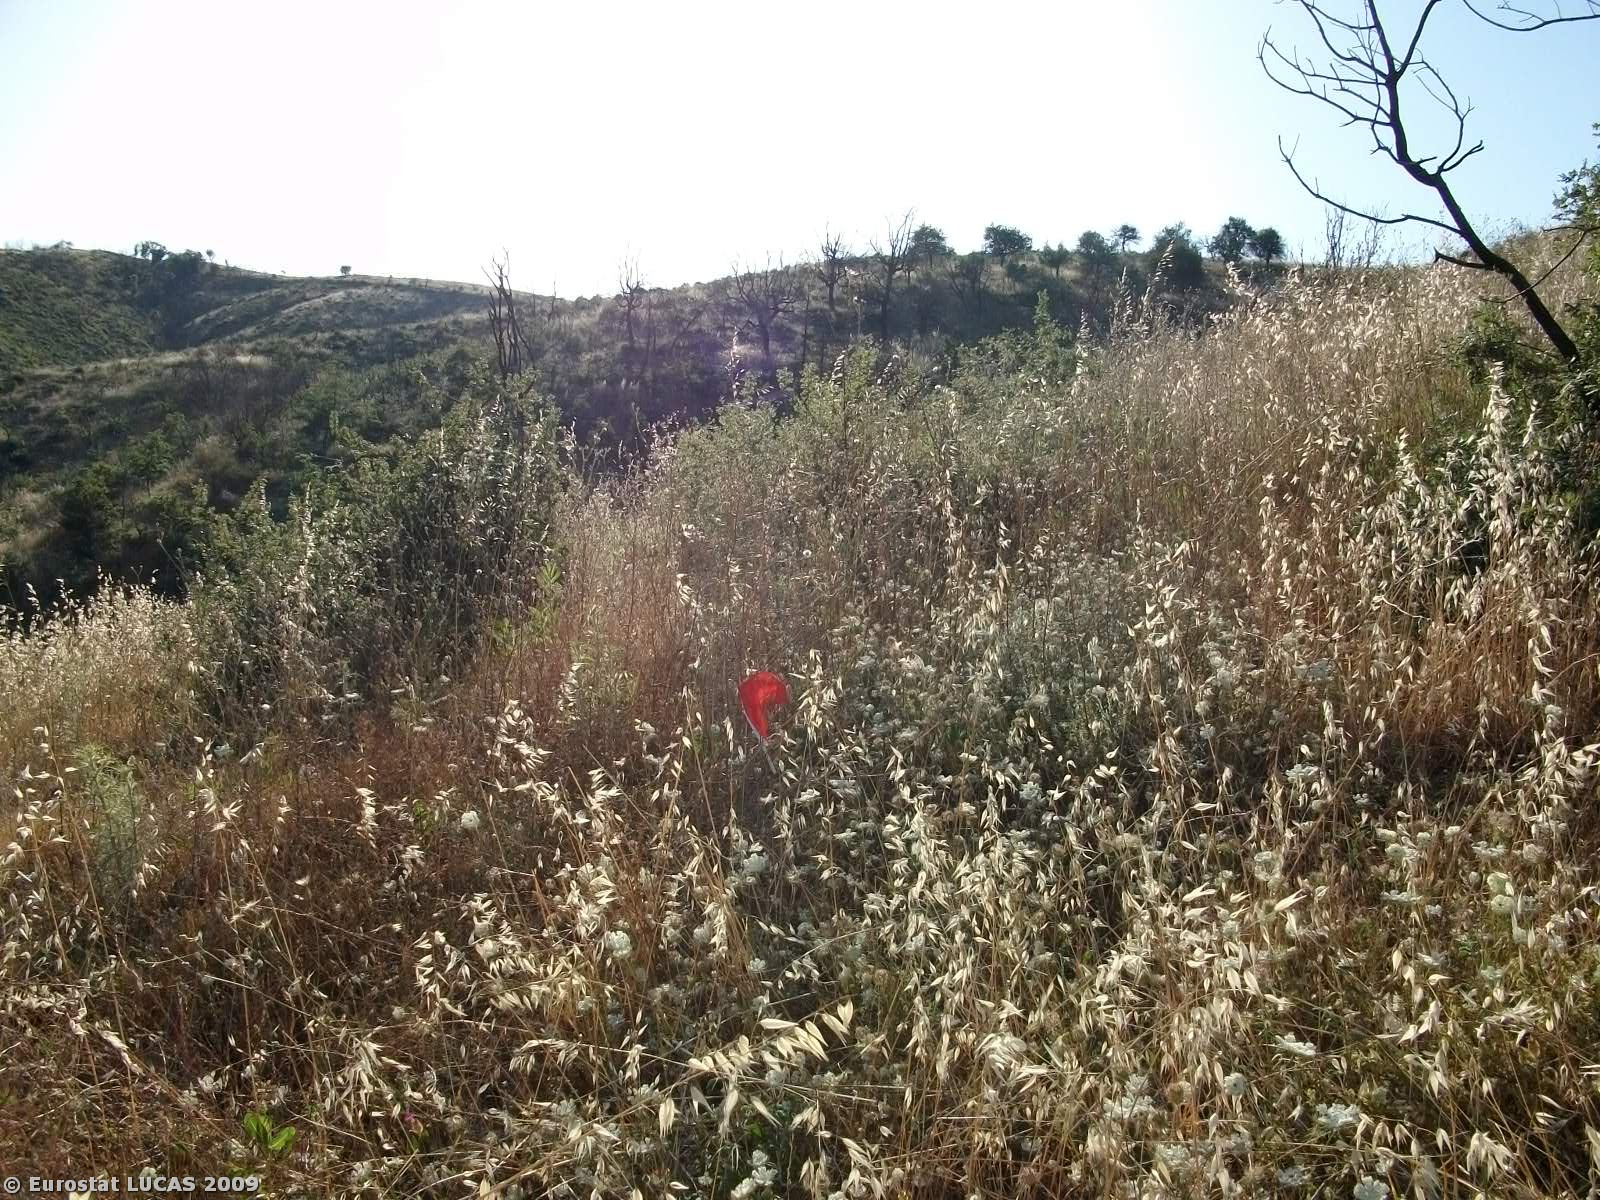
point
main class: Woodland
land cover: Broadleaved woodland
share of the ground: 50 - 75 %
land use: Forestry
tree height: < 5 m
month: June
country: GR
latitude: 37.2920
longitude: 22.1741
